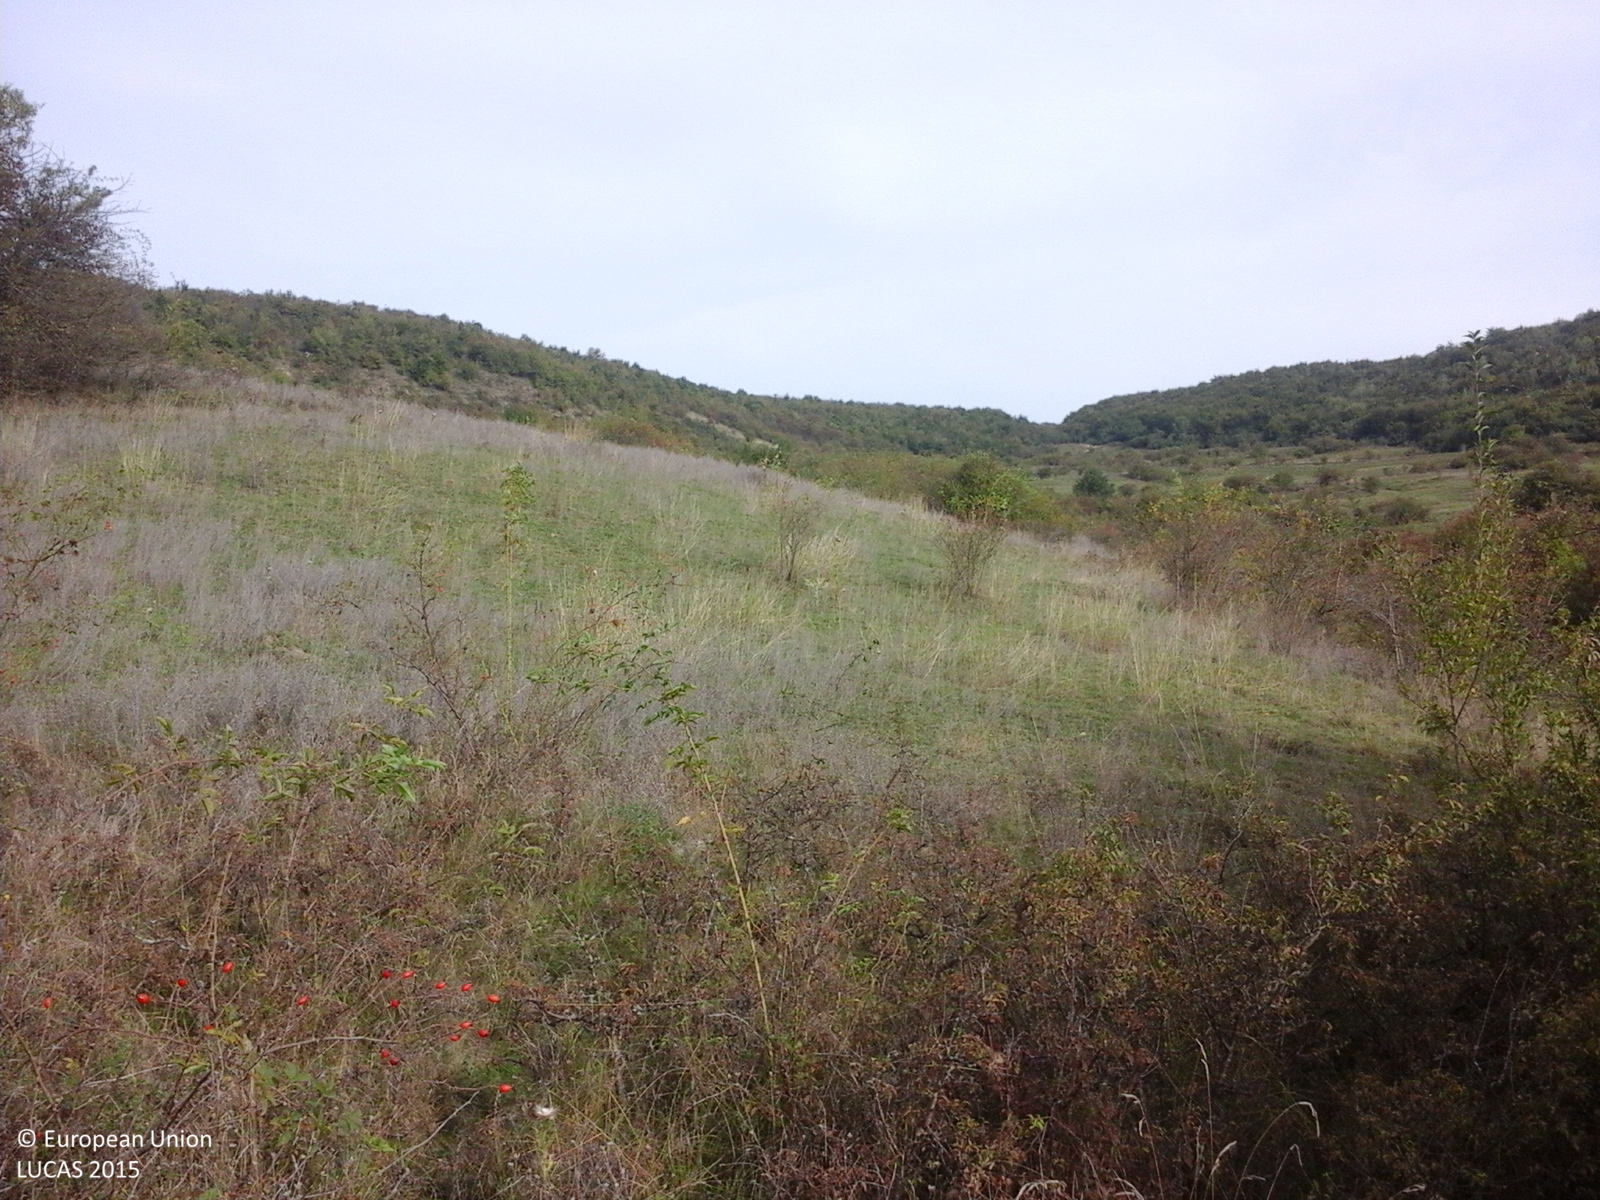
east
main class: Grassland
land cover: Spontaneously vegetated surfaces
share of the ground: > 75 %
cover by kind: herbaceous plants 100 %
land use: Fallow land
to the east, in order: Spontaneously vegetated surfaces; Shrubland without tree cover; Spontaneously vegetated surfaces
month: September
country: RO
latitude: 47.1287
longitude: 23.9617
